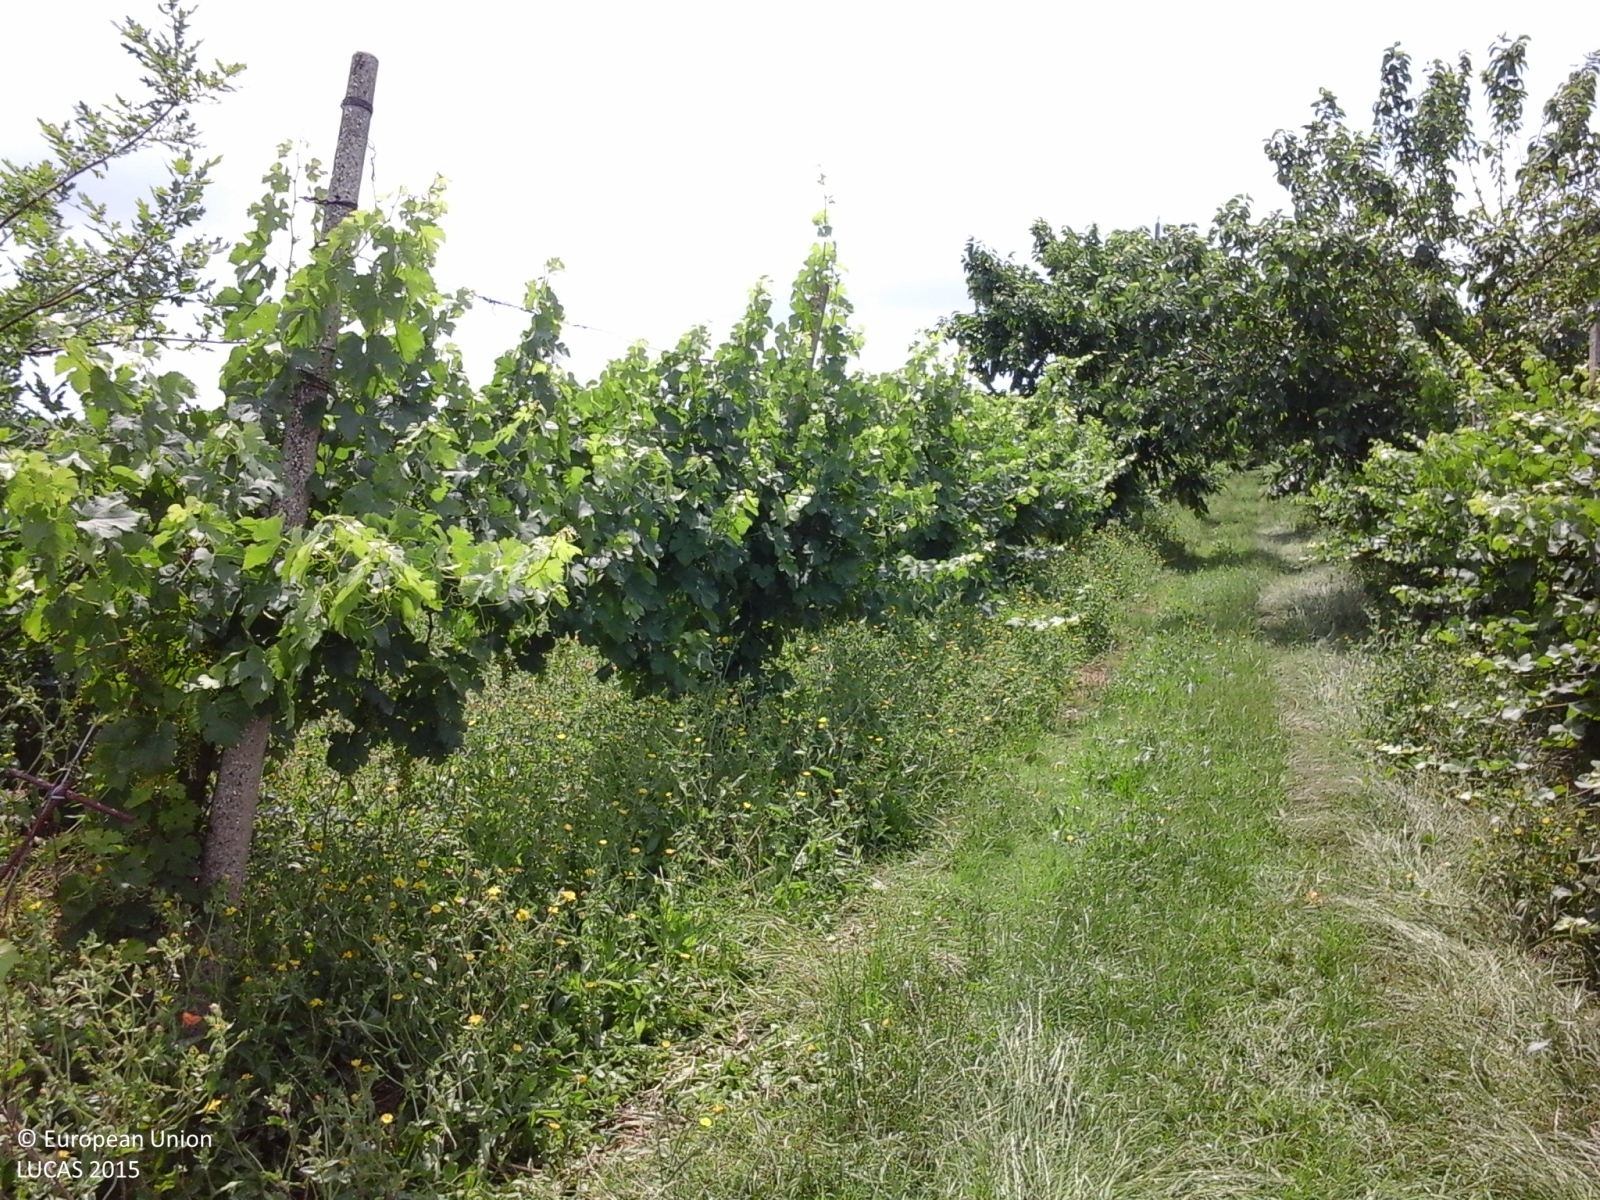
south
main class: Cropland
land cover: Maize
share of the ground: > 75 %
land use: Agriculture (excluding fallow land and kitchen gardens)
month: June
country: IT
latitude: 45.6514
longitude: 12.6525
